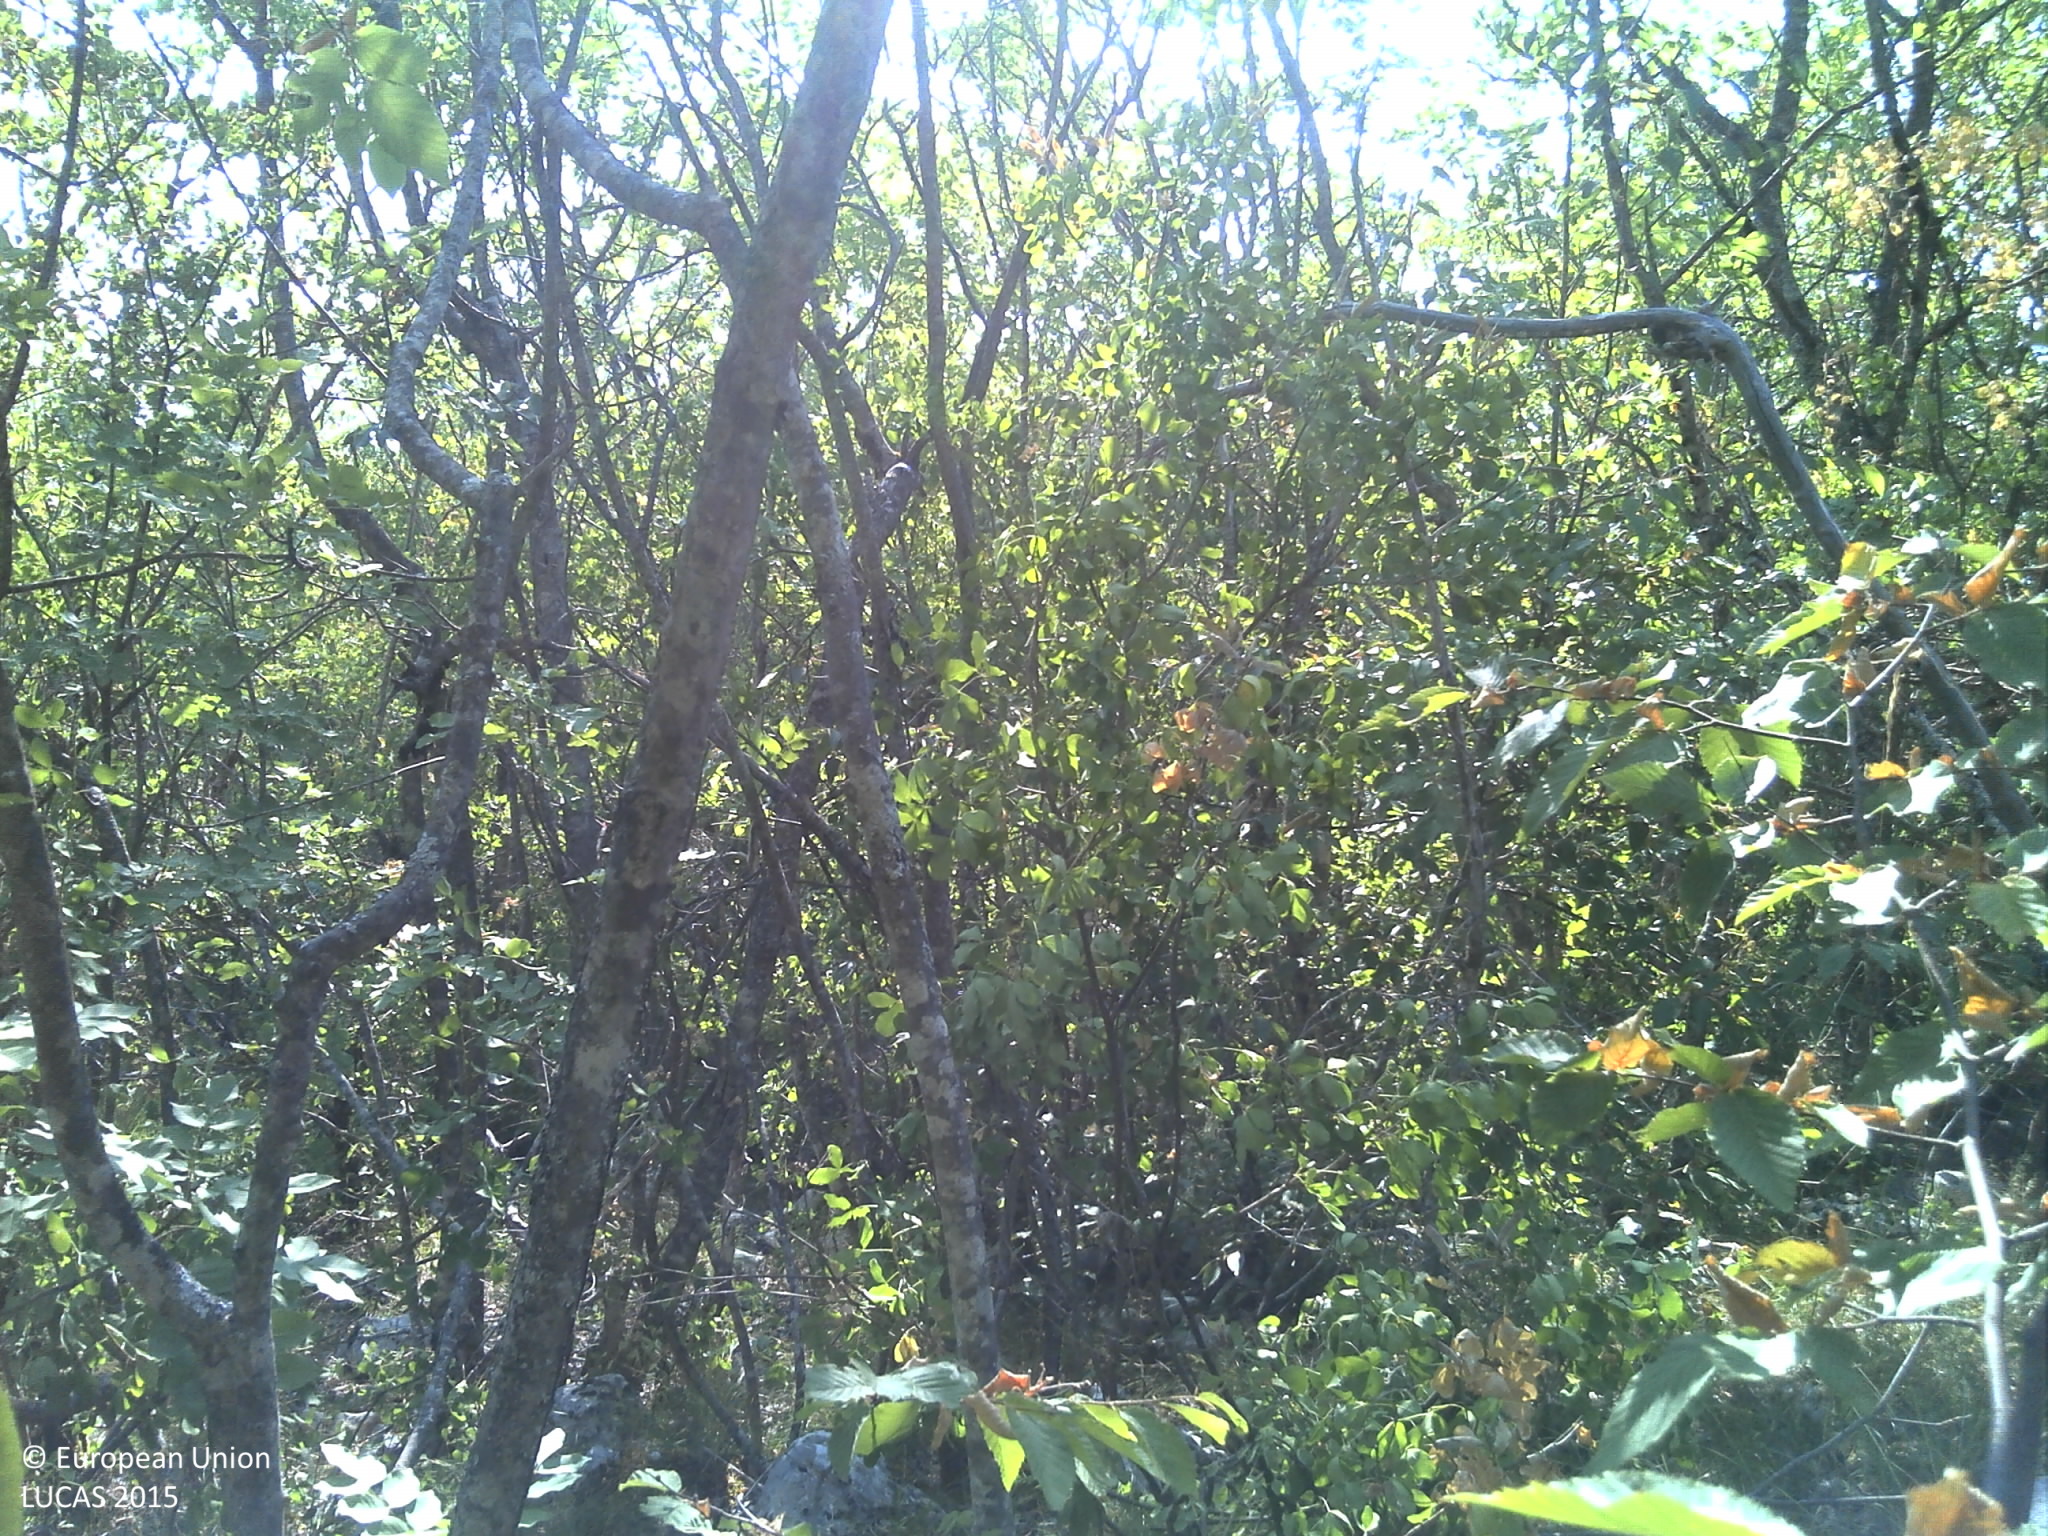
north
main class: Woodland
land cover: Broadleaved woodland
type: thermophilous deciduous forest
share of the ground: 50 - 75 %
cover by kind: broadleaved forest trees 65 %, shrubs 15 %, herbaceous plants 15 %, consolidated bare surface 5 %
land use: Semi-natural and natural areas not in use
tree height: > 5 m
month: July
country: HR
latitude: 43.4017
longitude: 17.0912
